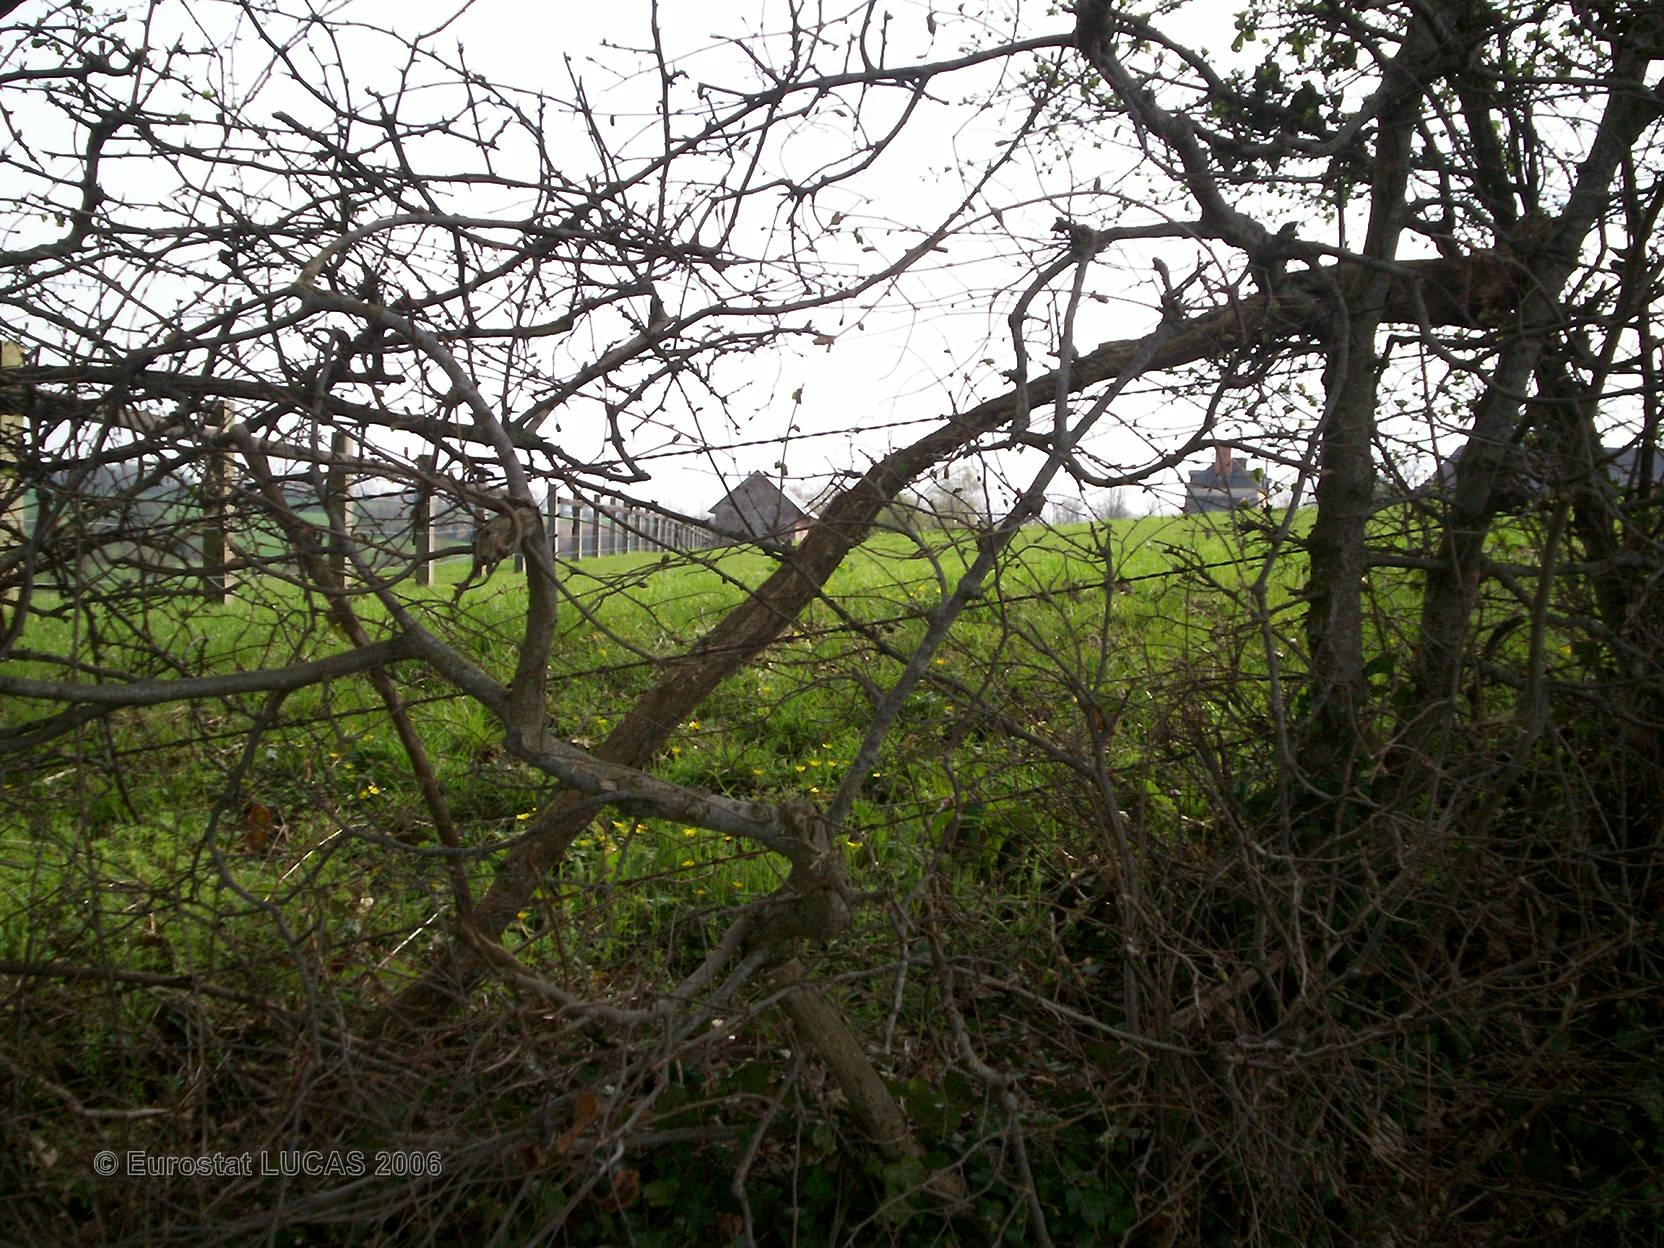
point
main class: Grassland
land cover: Grassland without tree/shrub cover
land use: Agriculture (excluding fallow land and kitchen gardens)
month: April
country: FR
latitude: 48.7506
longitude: 0.2476
